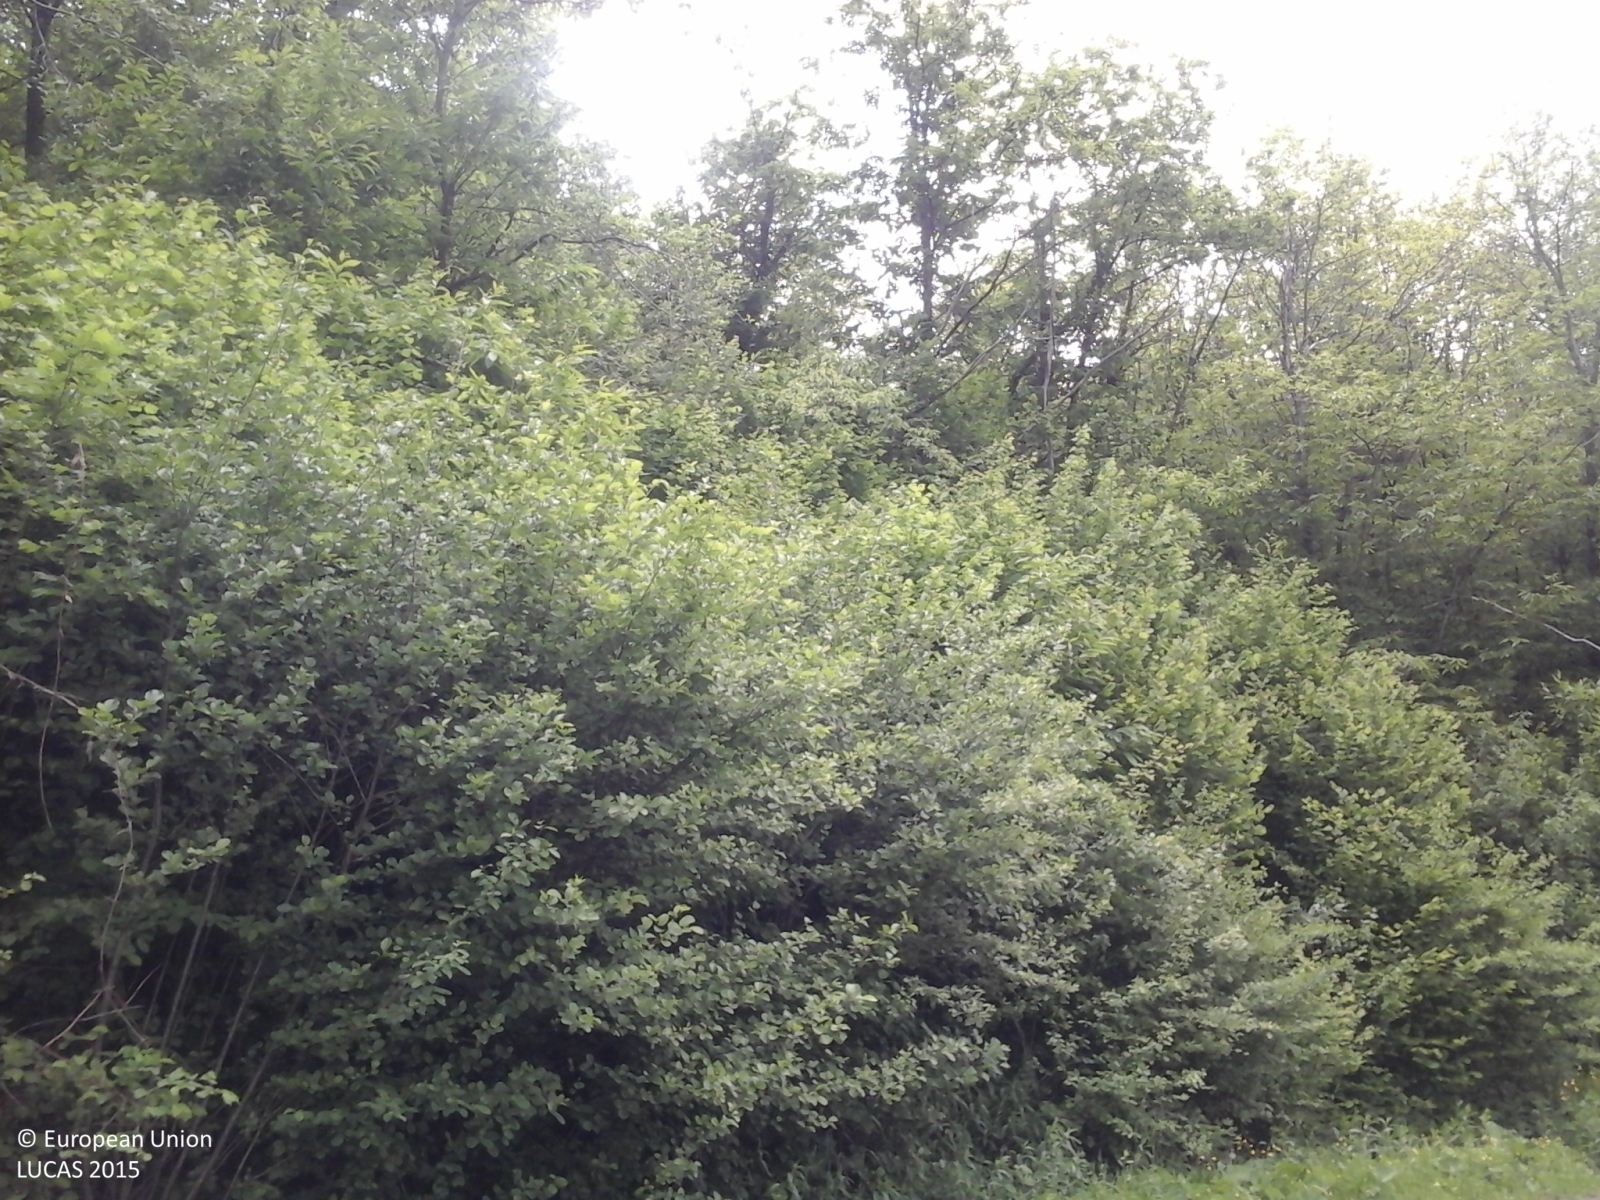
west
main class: Woodland
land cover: Broadleaved woodland
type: thermophilous deciduous forest
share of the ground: > 75 %
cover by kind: broadleaved forest trees 70 %, shrubs 30 %
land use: Forestry
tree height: > 5 m
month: May
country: IT
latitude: 44.4761
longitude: 9.6111
